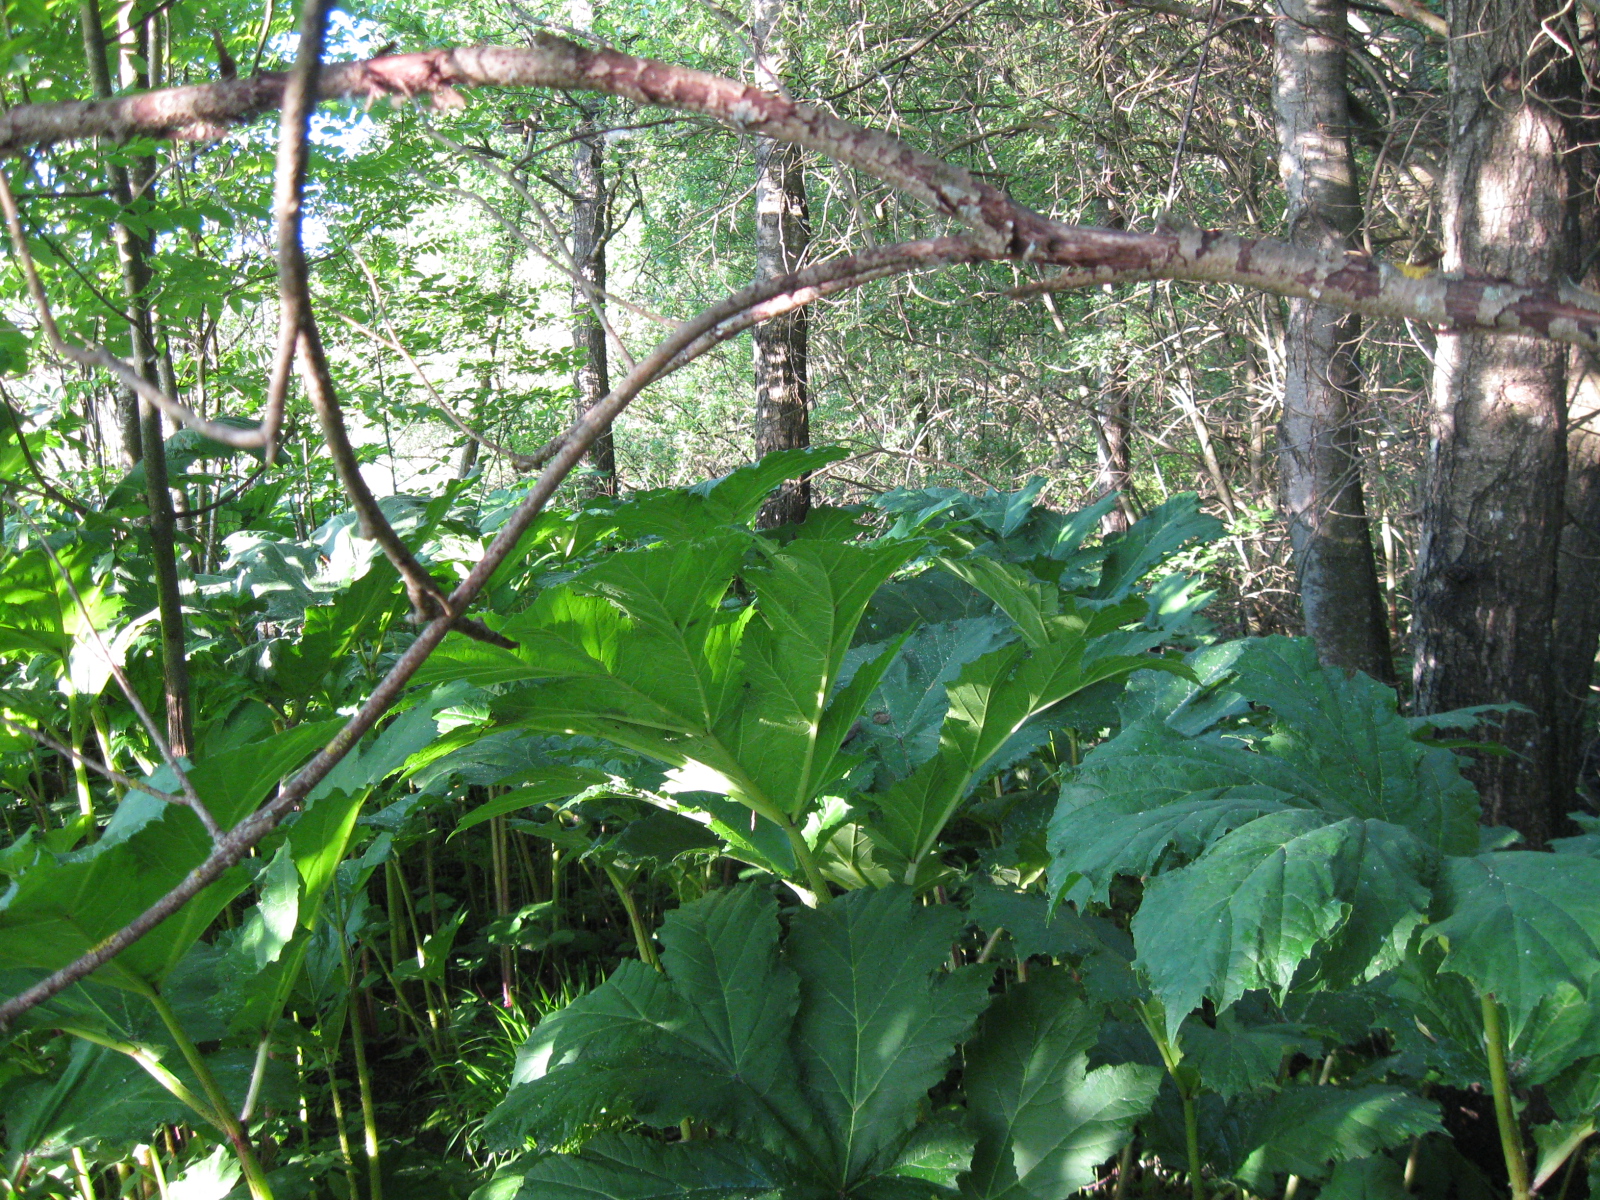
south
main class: Woodland
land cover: Broadleaved woodland
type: non-riverine alder, birch or aspen forest
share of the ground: > 75 %
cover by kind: broadleaved forest trees 90 %, herbaceous plants 10 %
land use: Forestry
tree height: > 5 m
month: June
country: LT
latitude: 55.0664
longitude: 24.0116
